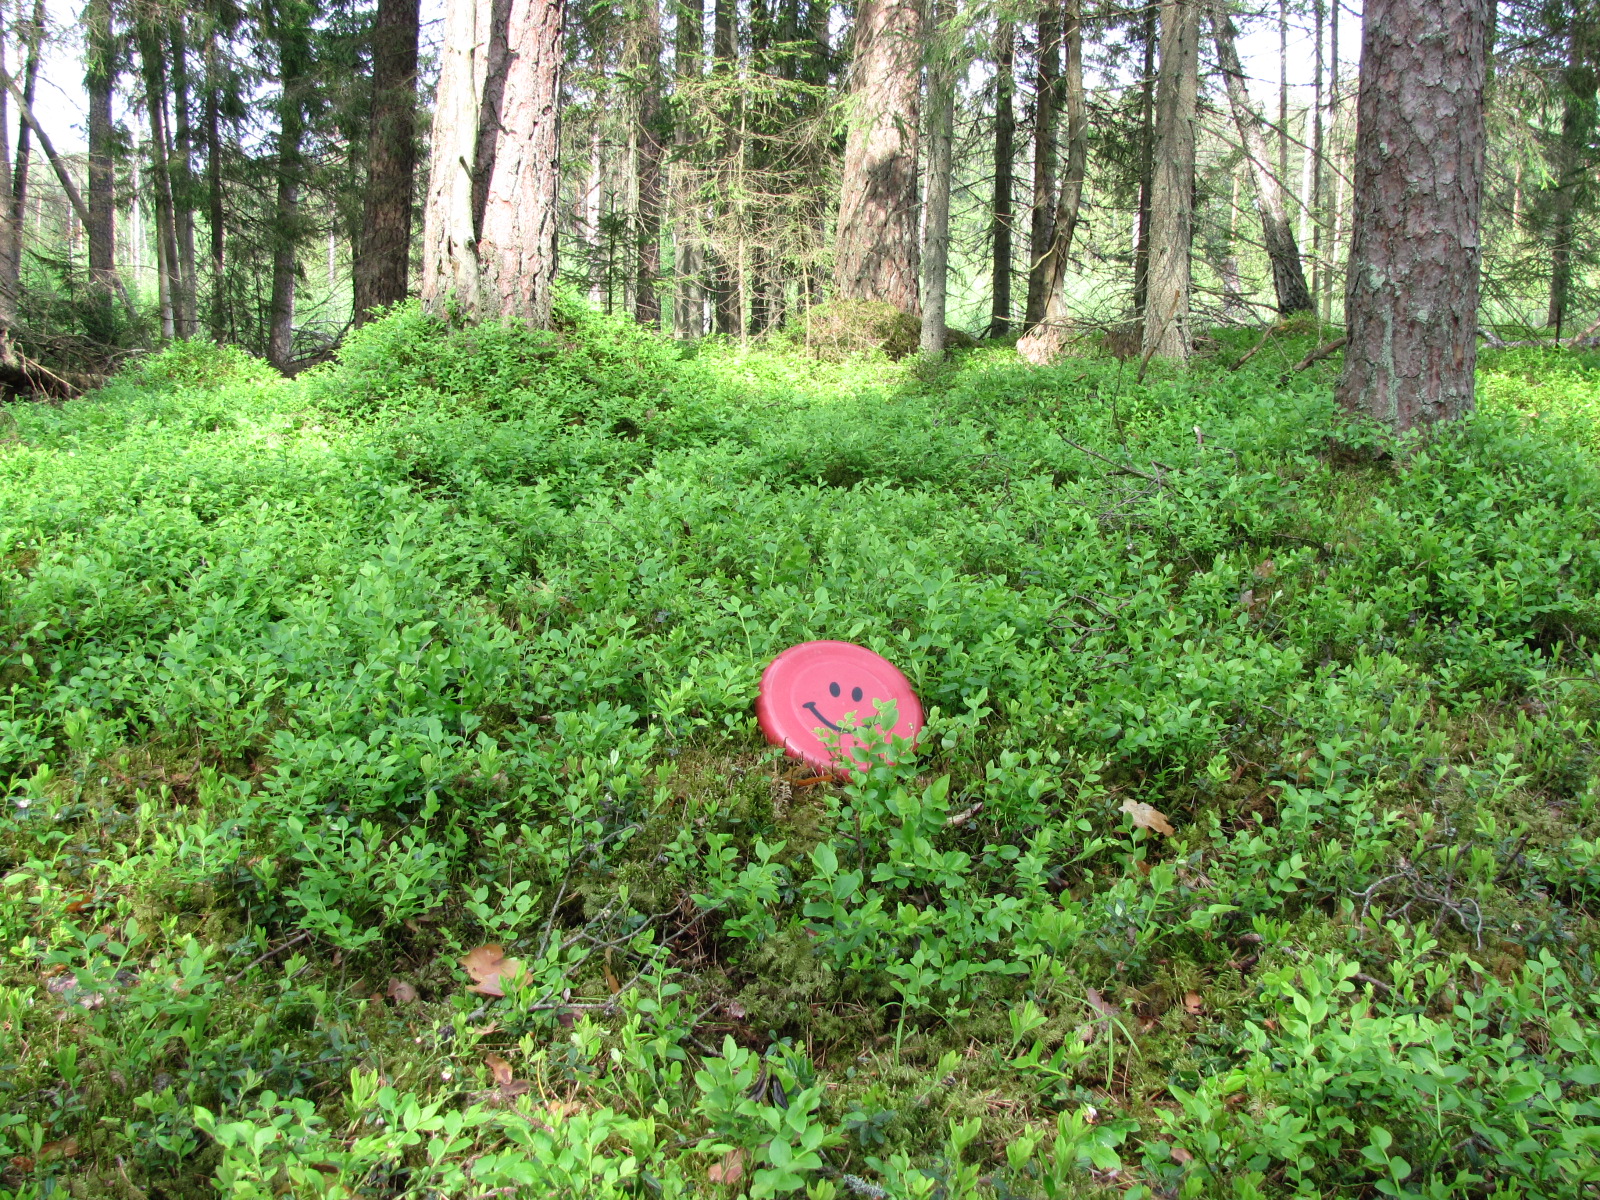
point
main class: Woodland
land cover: Other coniferous woodland
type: hemiboreal forest and nemoral coniferous forest and mixed broadleaved-coniferous forest
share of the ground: > 75 %
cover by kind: coniferous forest trees 90 %, herbaceous plants 5 %, lichens and mosses 5 %
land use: Forestry
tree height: > 5 m
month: June
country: LV
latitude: 56.6371
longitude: 24.3584
